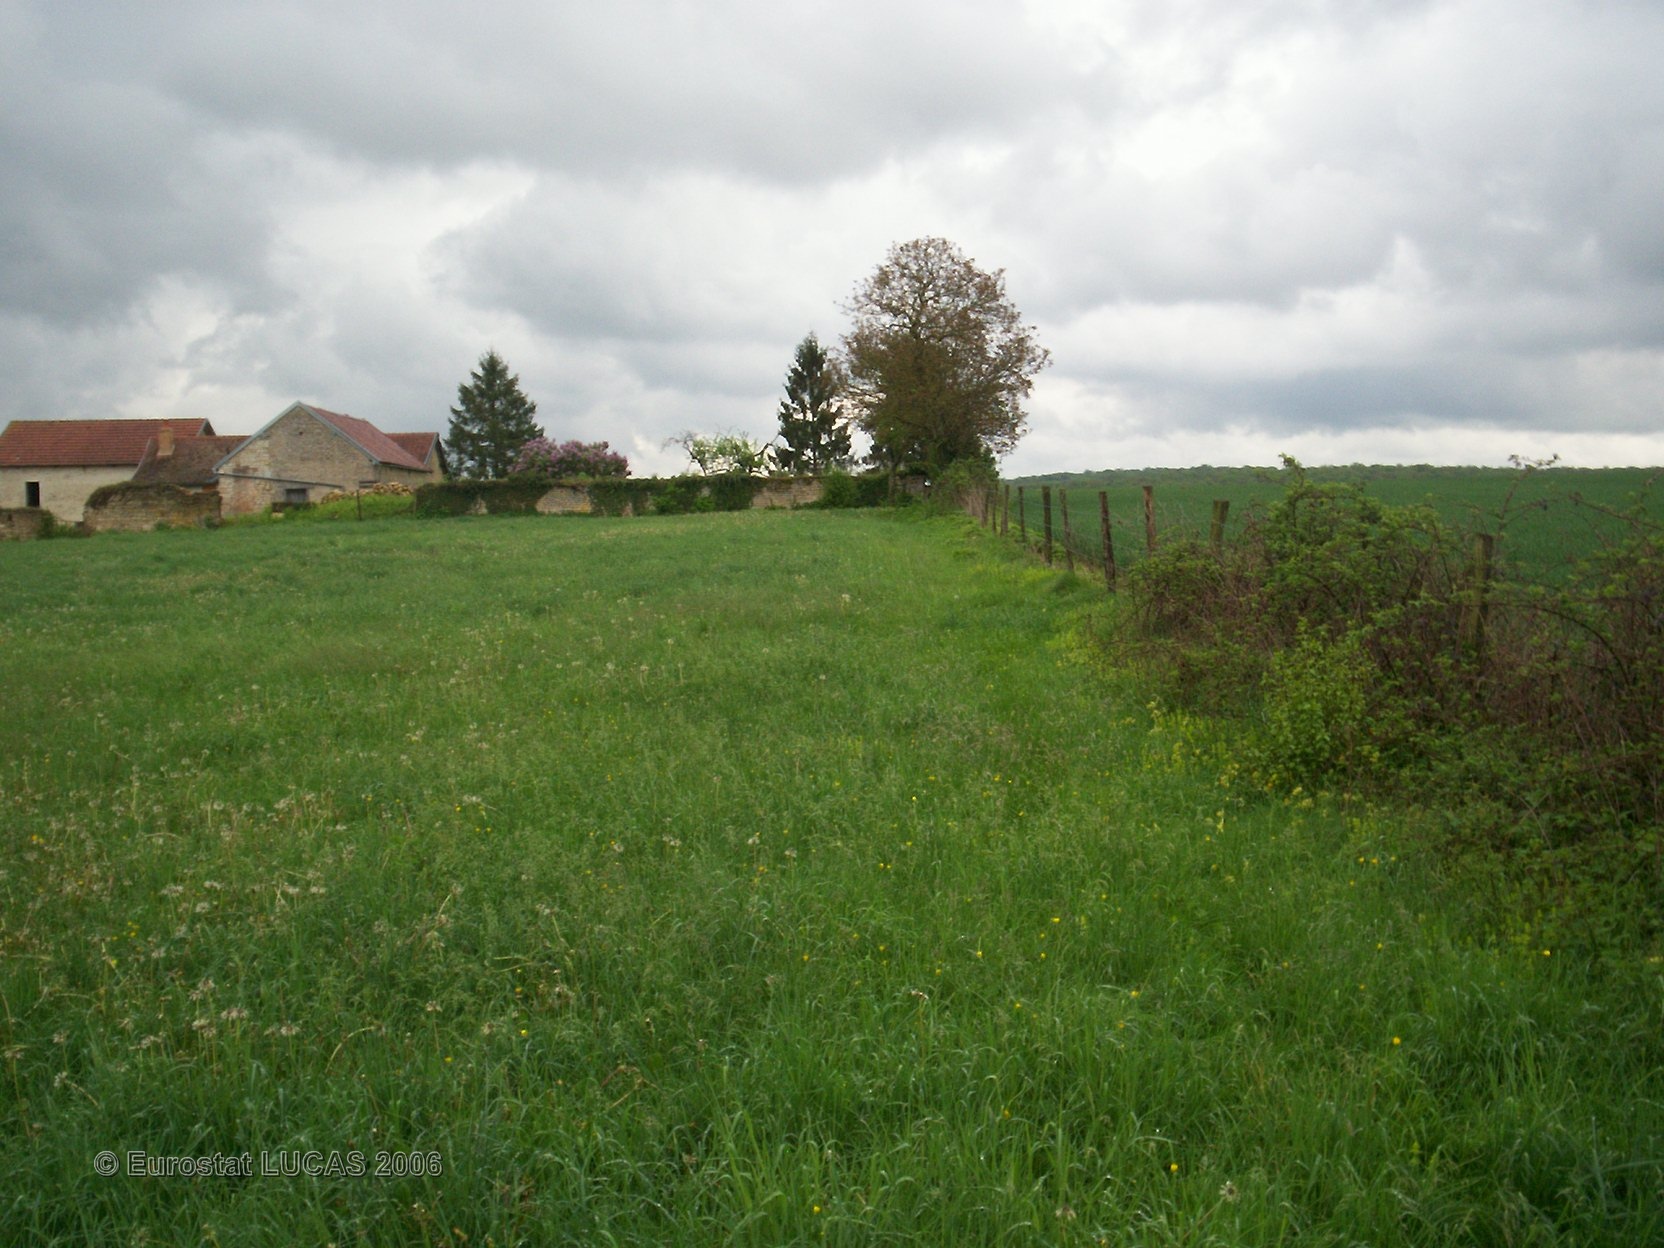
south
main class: Grassland
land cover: Grassland without tree/shrub cover
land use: Agriculture (excluding fallow land and kitchen gardens)
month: May
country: FR
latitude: 47.7816
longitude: 4.5399
